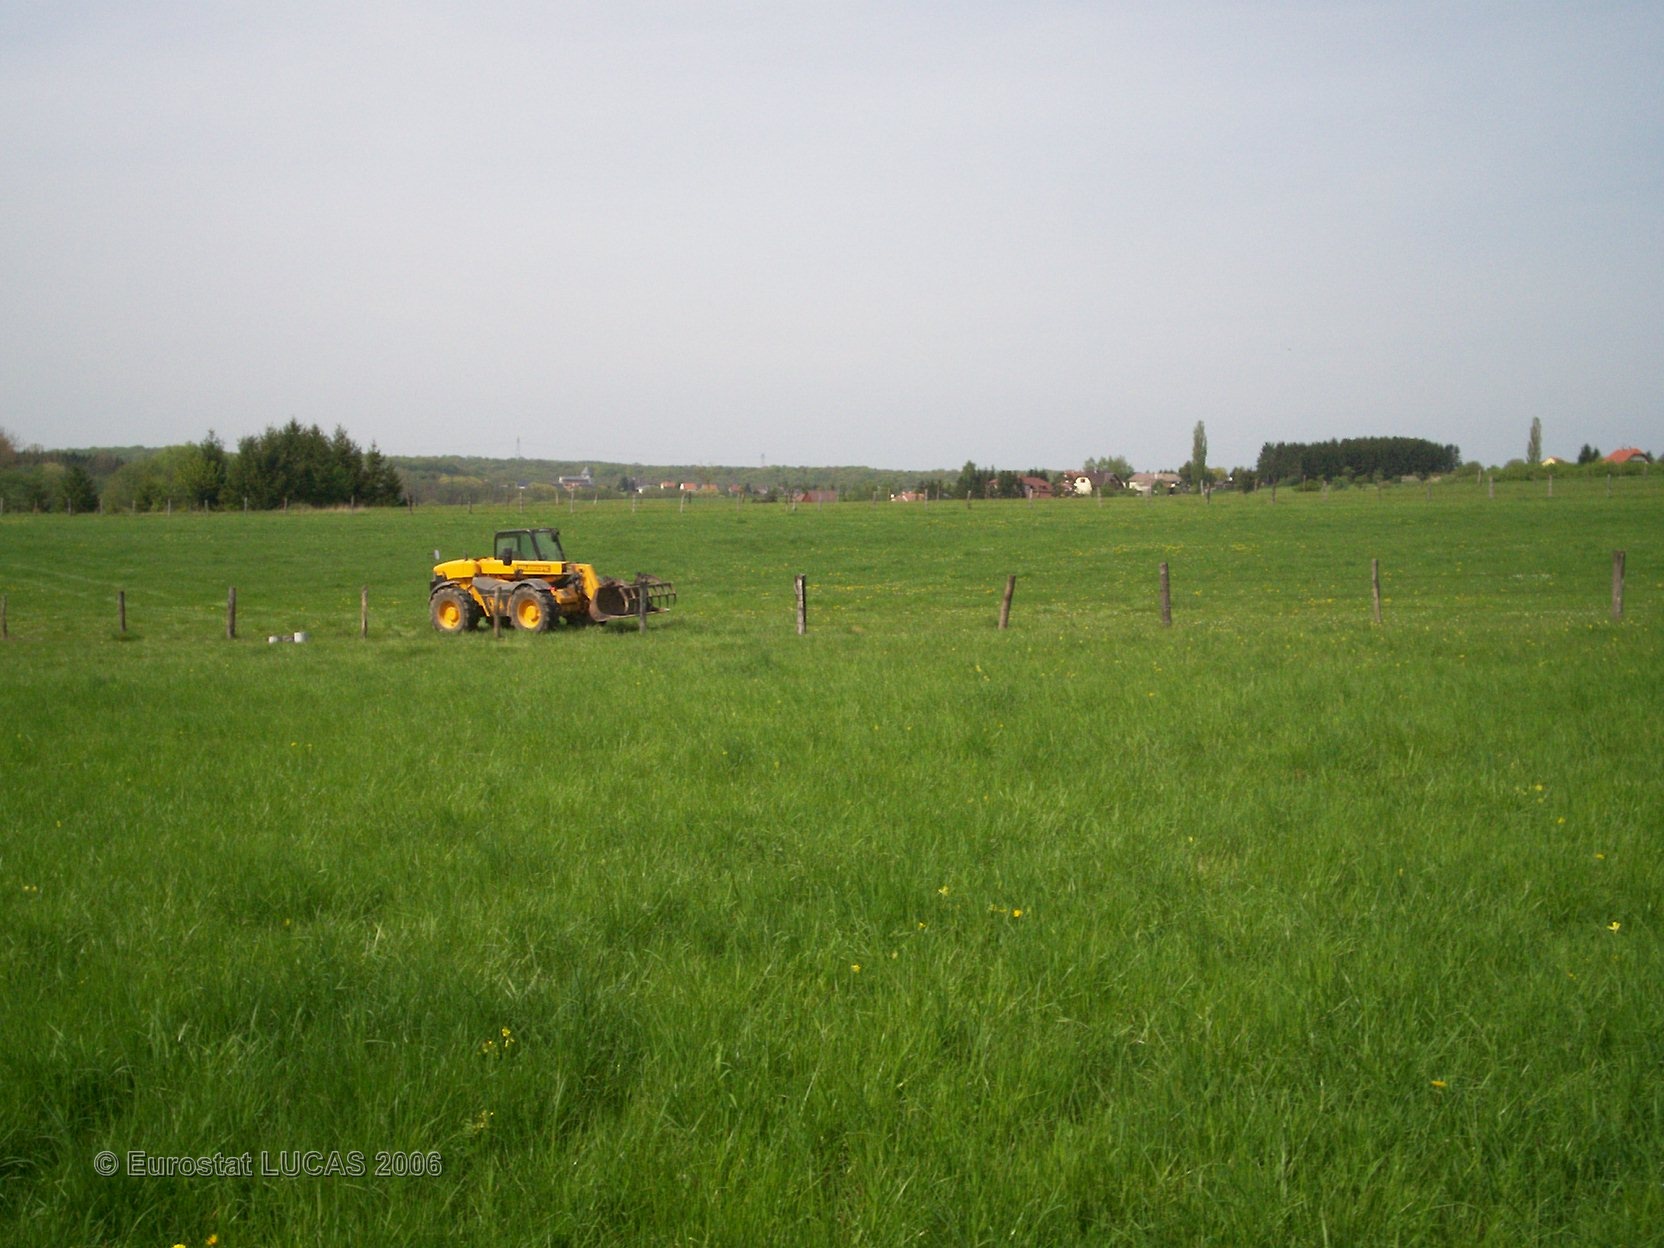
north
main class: Grassland
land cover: Grassland without tree/shrub cover
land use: Agriculture (excluding fallow land and kitchen gardens)
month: May
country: FR
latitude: 49.0665
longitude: 7.0577
